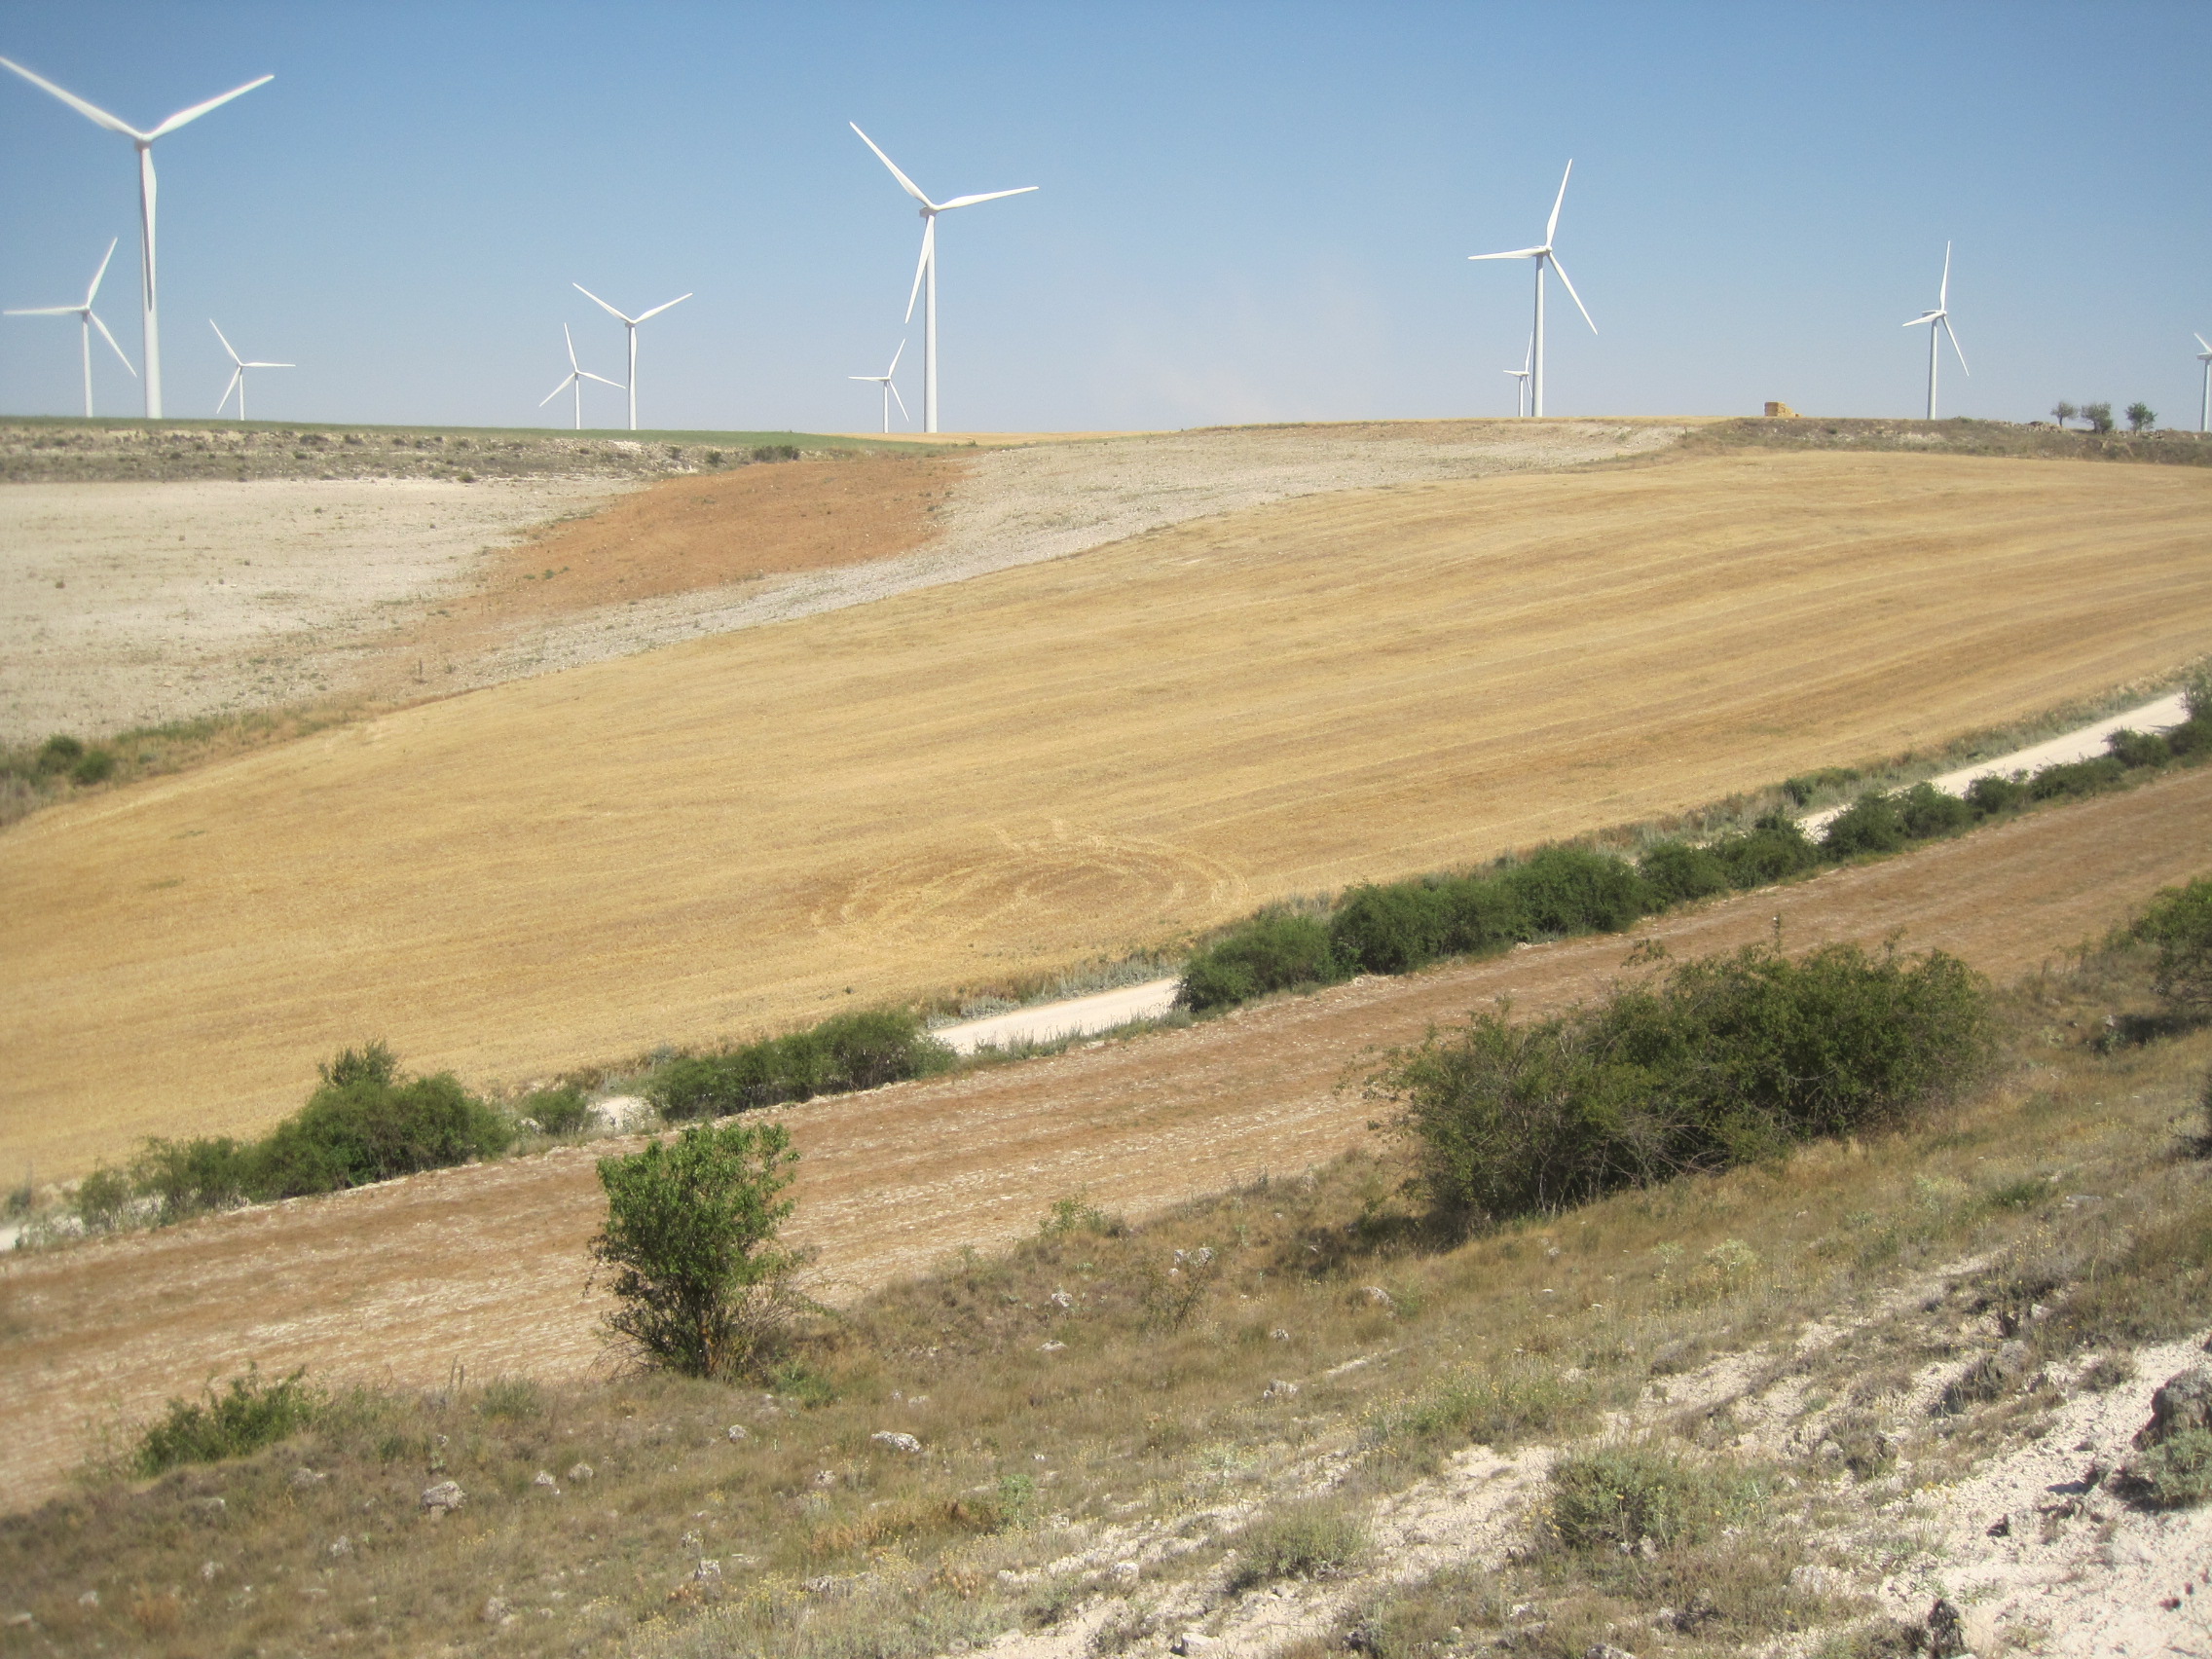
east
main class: Grassland
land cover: Grassland without tree/shrub cover
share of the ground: > 75 %
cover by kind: herbaceous plants 95 %, shrubs 5 %
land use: Semi-natural and natural areas not in use
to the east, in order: Grassland without tree/shrub cover; Dry pulses; Grassland without tree/shrub cover; Tracks; Grass margins; Barley; Other bare soil; Rock outcrops; Spontaneously vegetated surfaces; Tracks; Grass margins; Lucerne
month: July
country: ES
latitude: 41.9126
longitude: -4.7698
